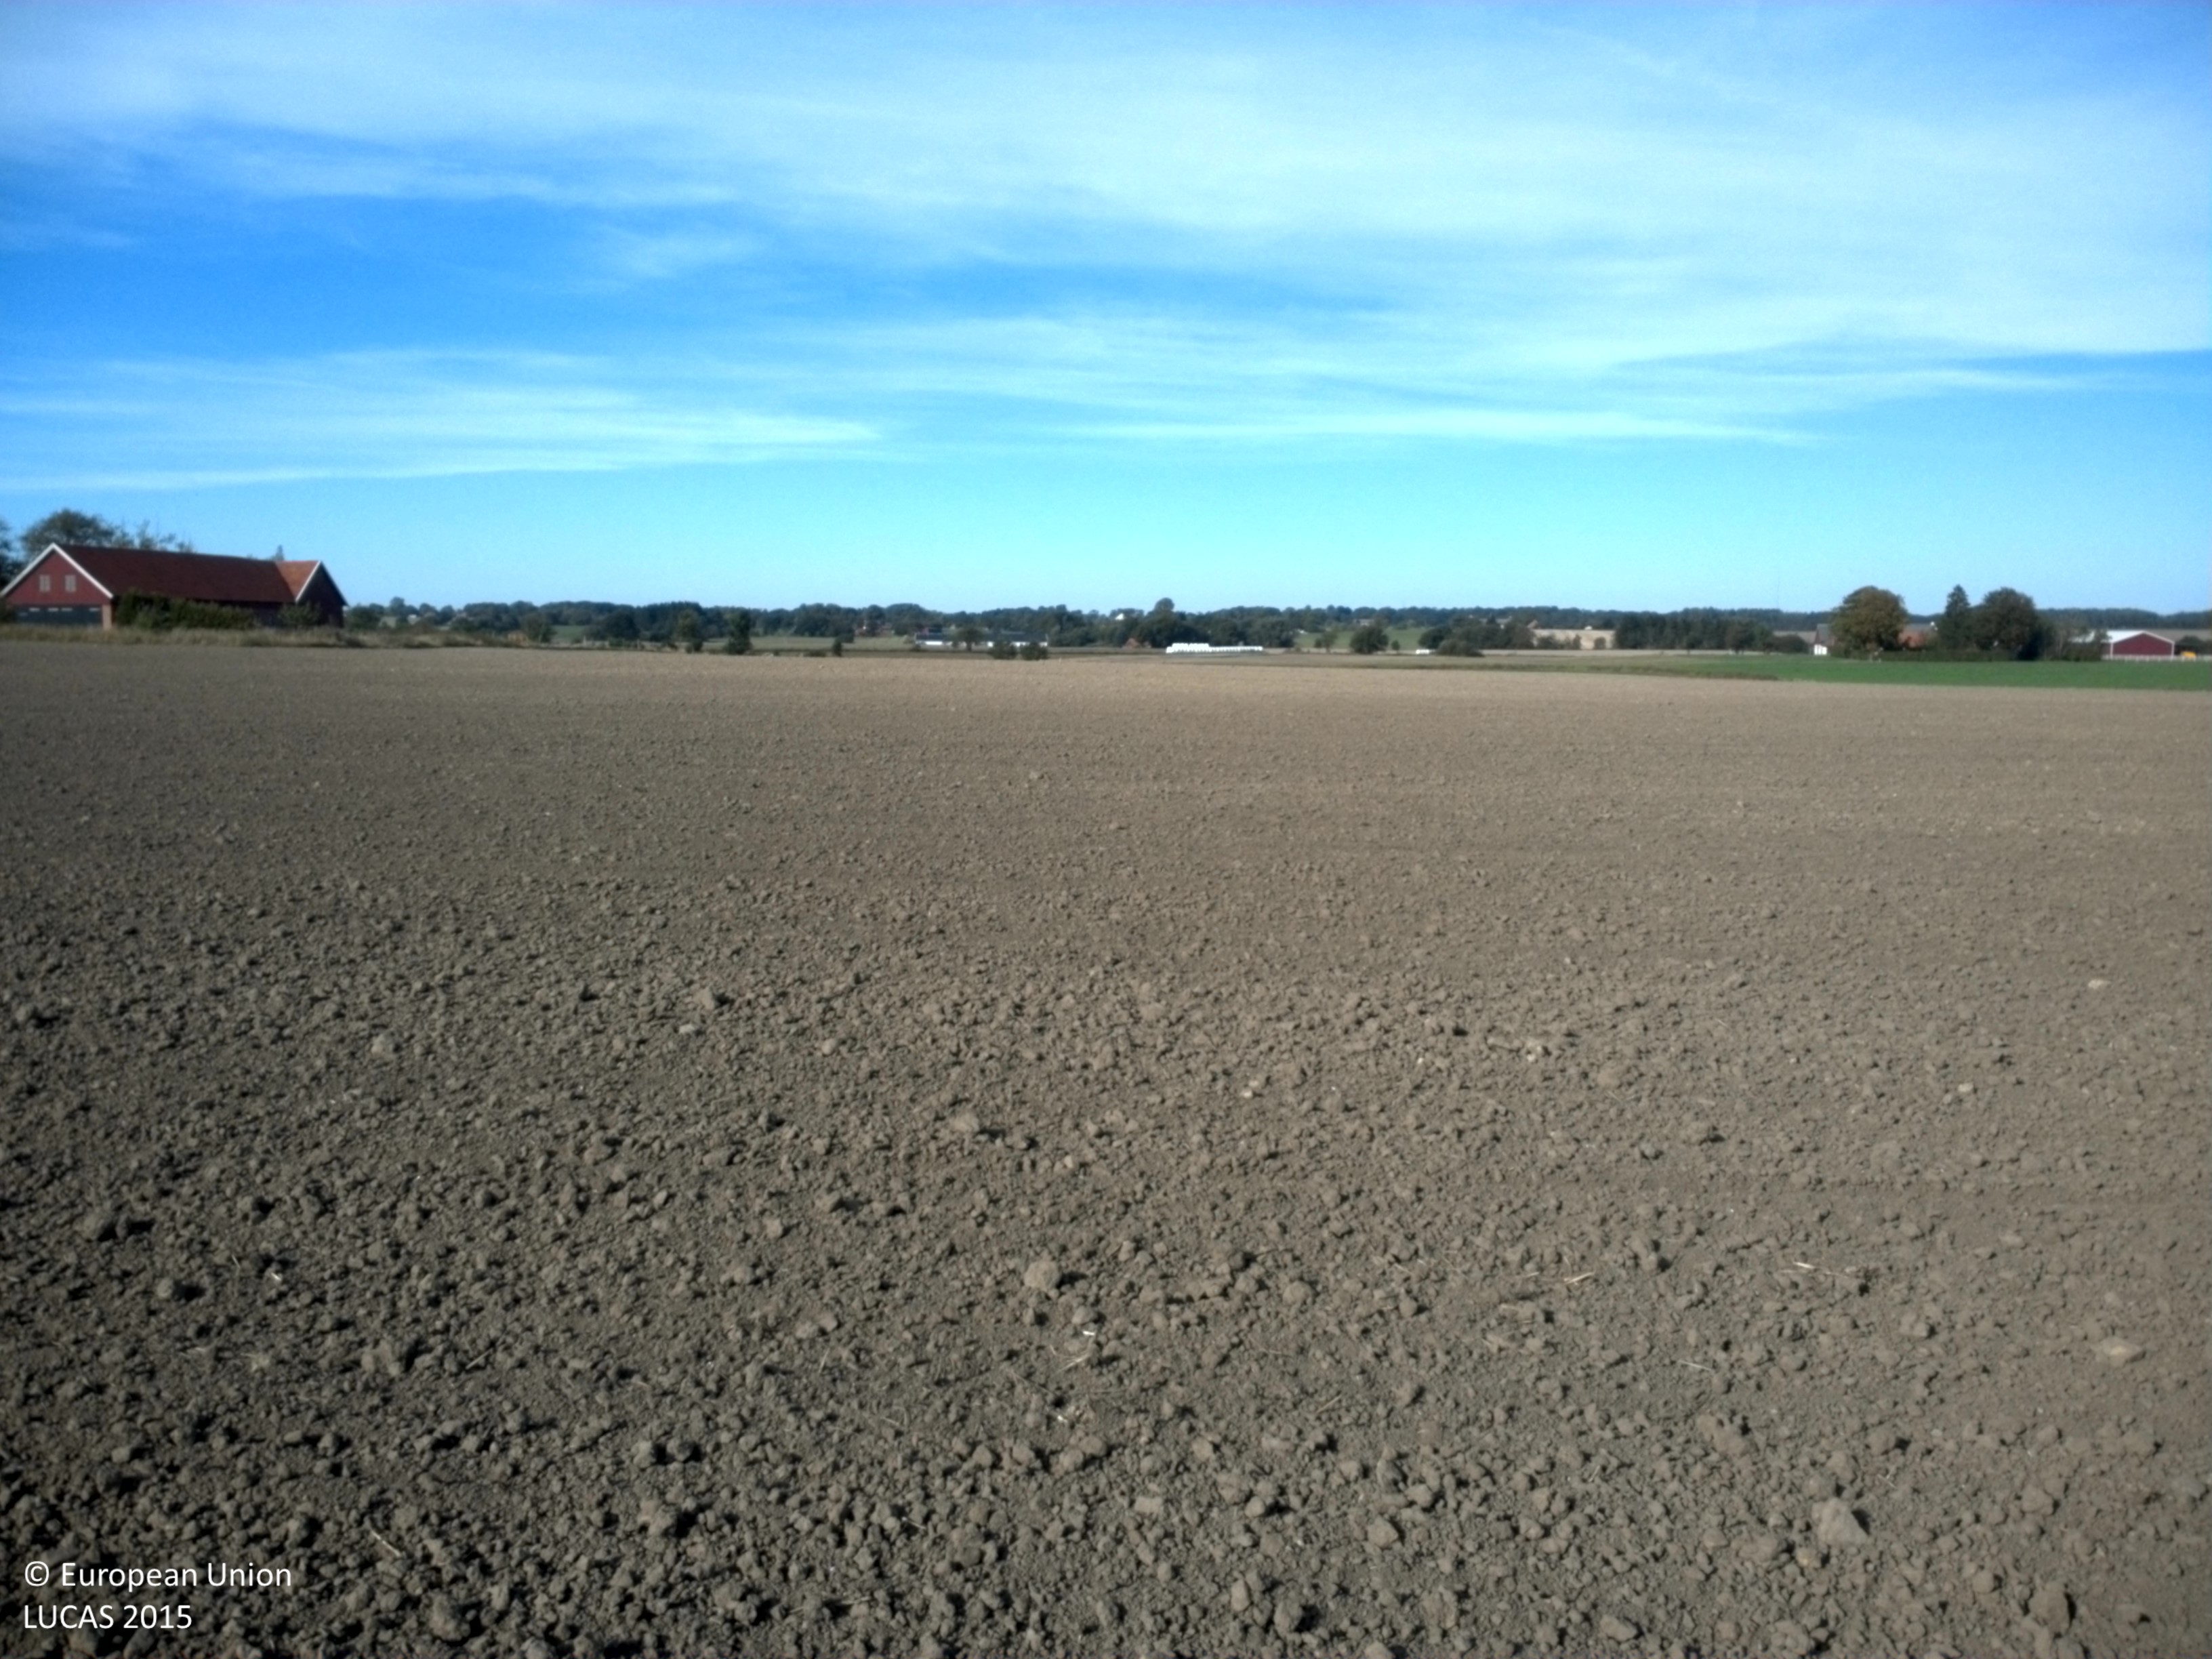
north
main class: Cropland
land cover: Common wheat
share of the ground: < 10 %
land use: Agriculture (excluding fallow land and kitchen gardens)
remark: Tilled/Sowed
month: October
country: SE
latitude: 55.7024
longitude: 13.7057
